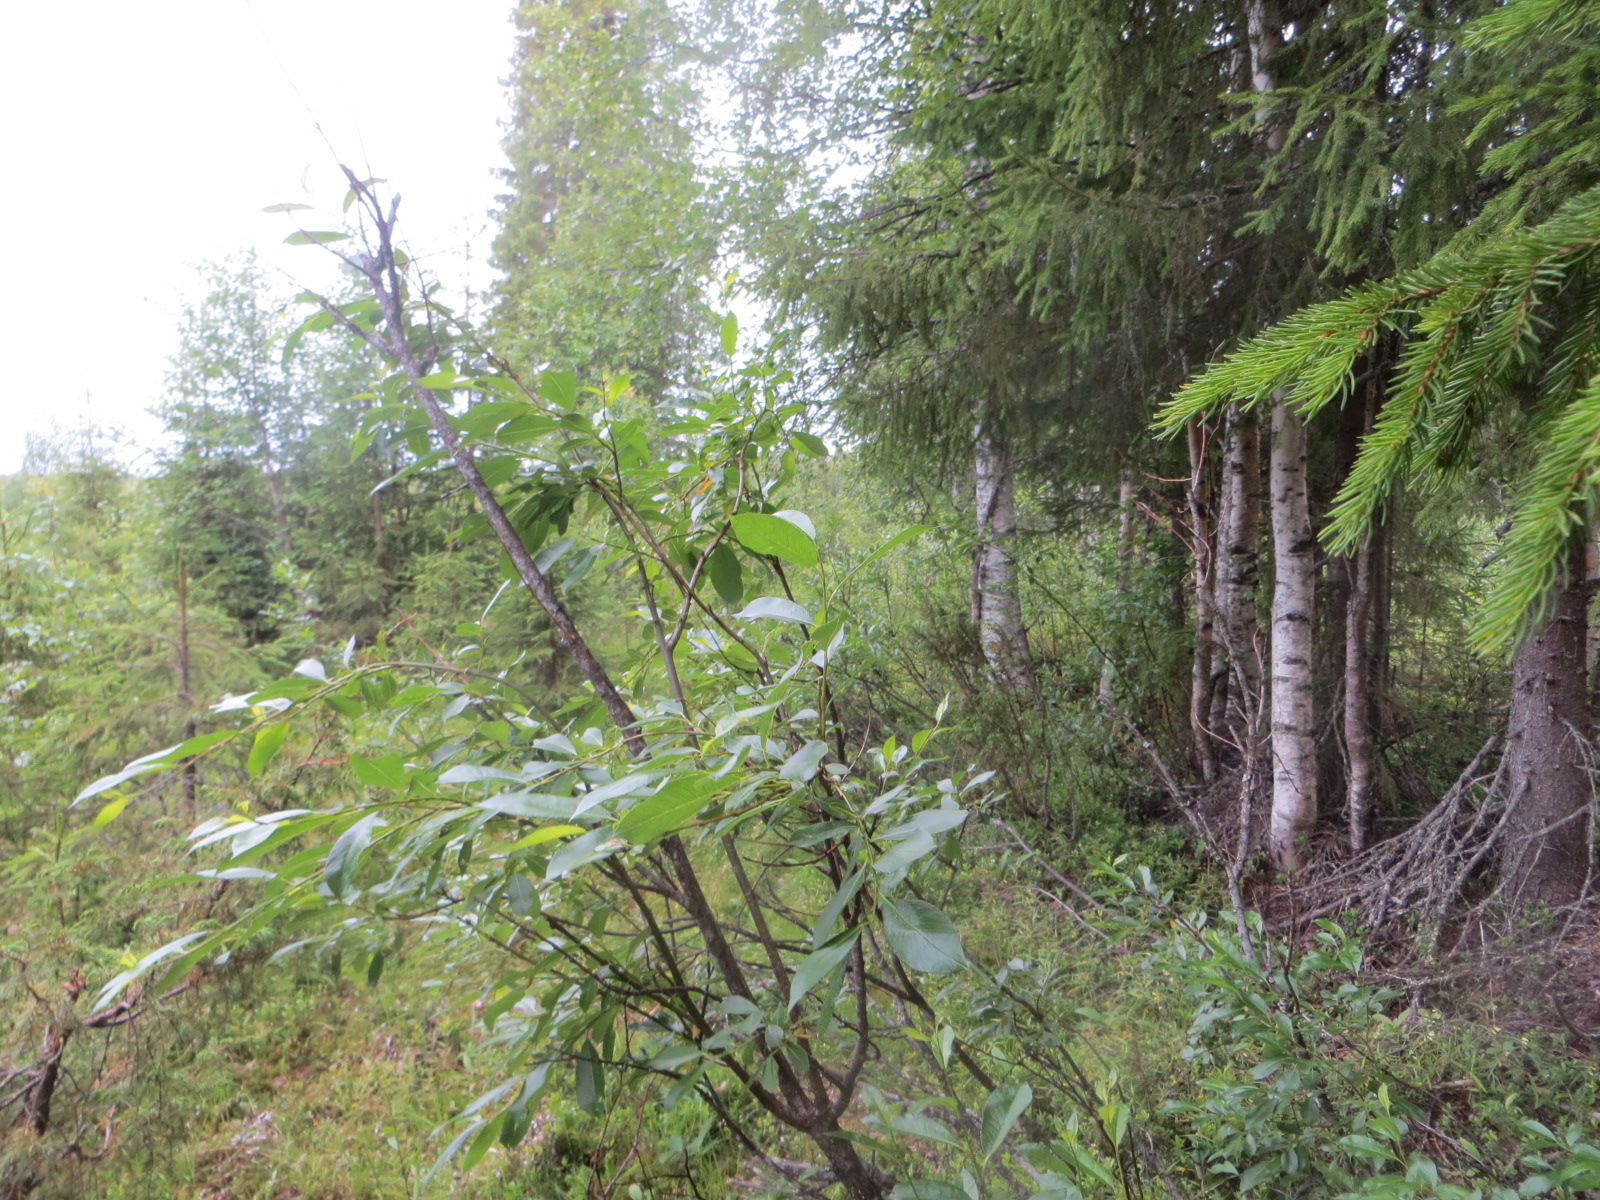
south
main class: Woodland
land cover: Other mixed woodland
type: boreal forest
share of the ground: 50 - 75 %
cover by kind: coniferous forest trees 40 %, broadleaved forest trees 30 %, shrubs 30 %
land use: Forestry
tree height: > 5 m
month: July
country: FI
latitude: 65.9442
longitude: 26.0678
